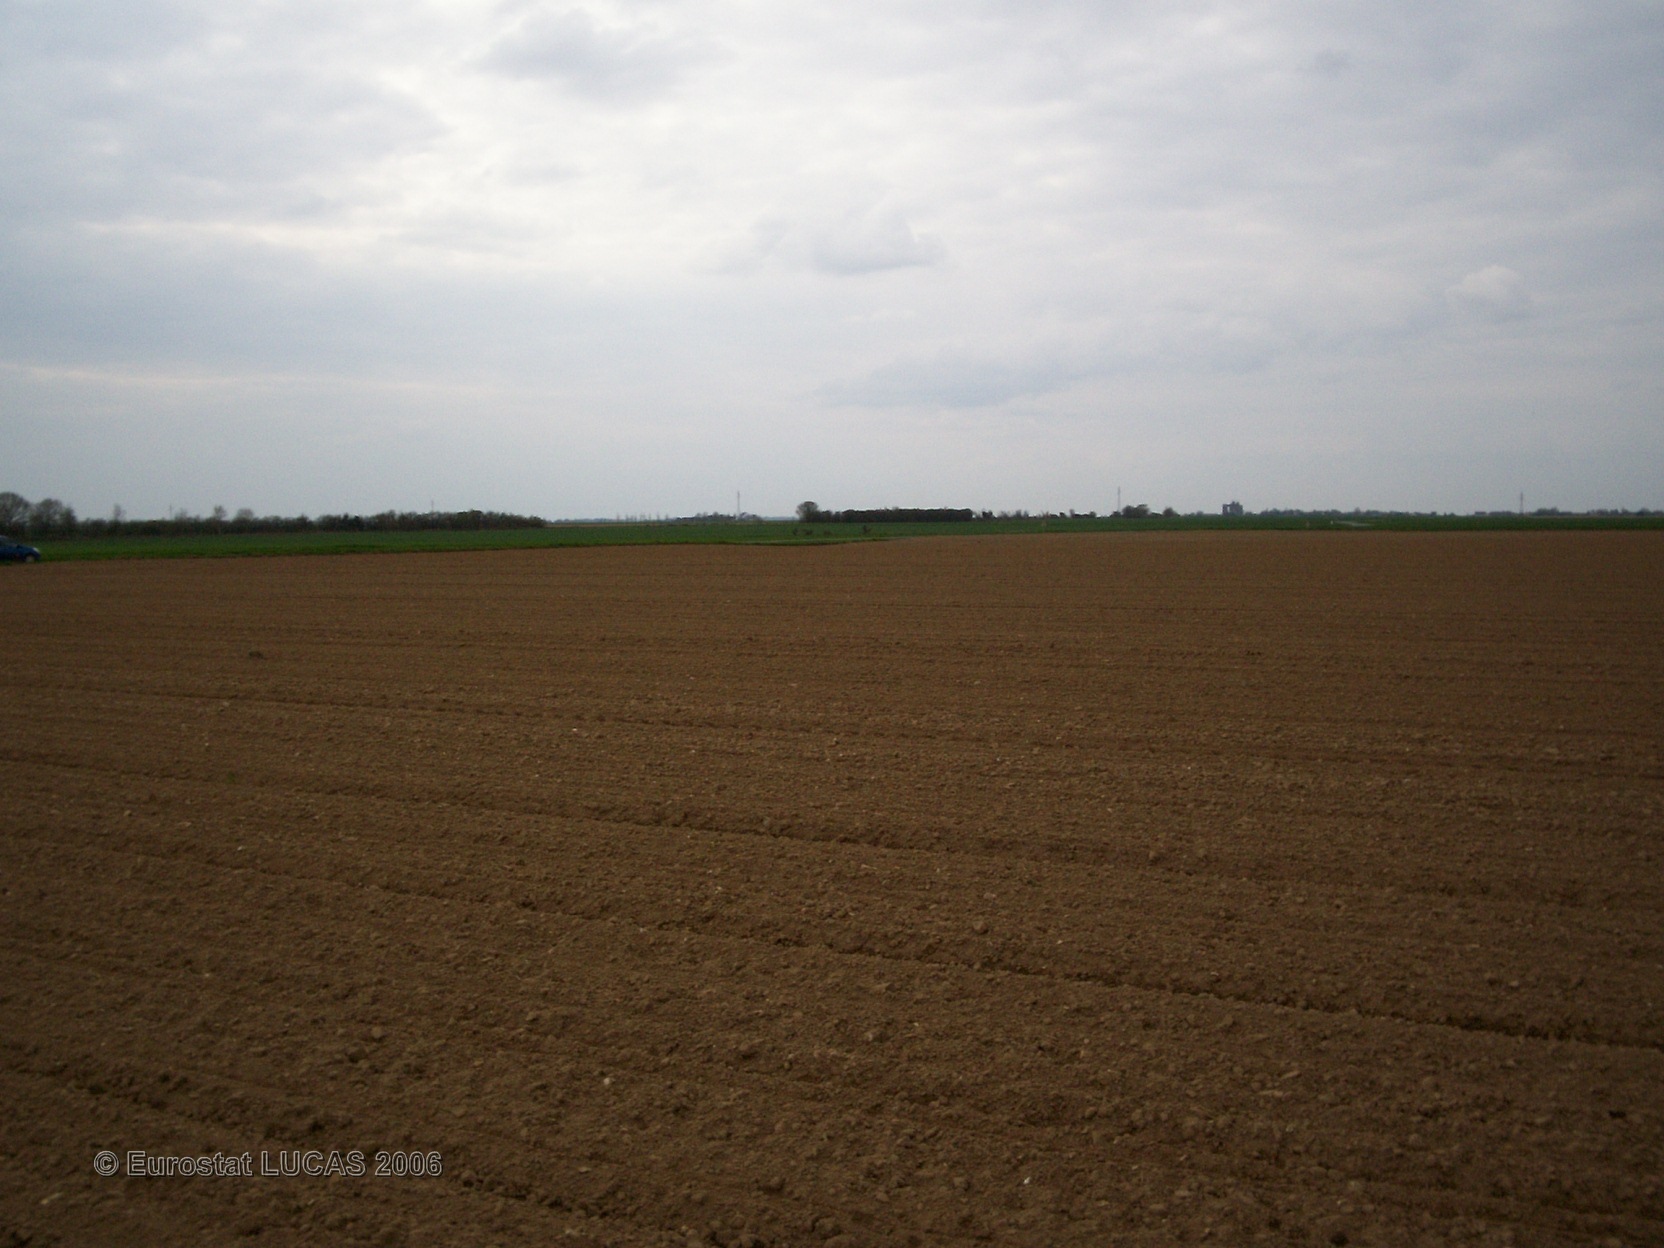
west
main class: Cropland
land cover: Sugar beet
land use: Agriculture (excluding fallow land and kitchen gardens)
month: April
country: FR
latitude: 49.0730
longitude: 1.0673
